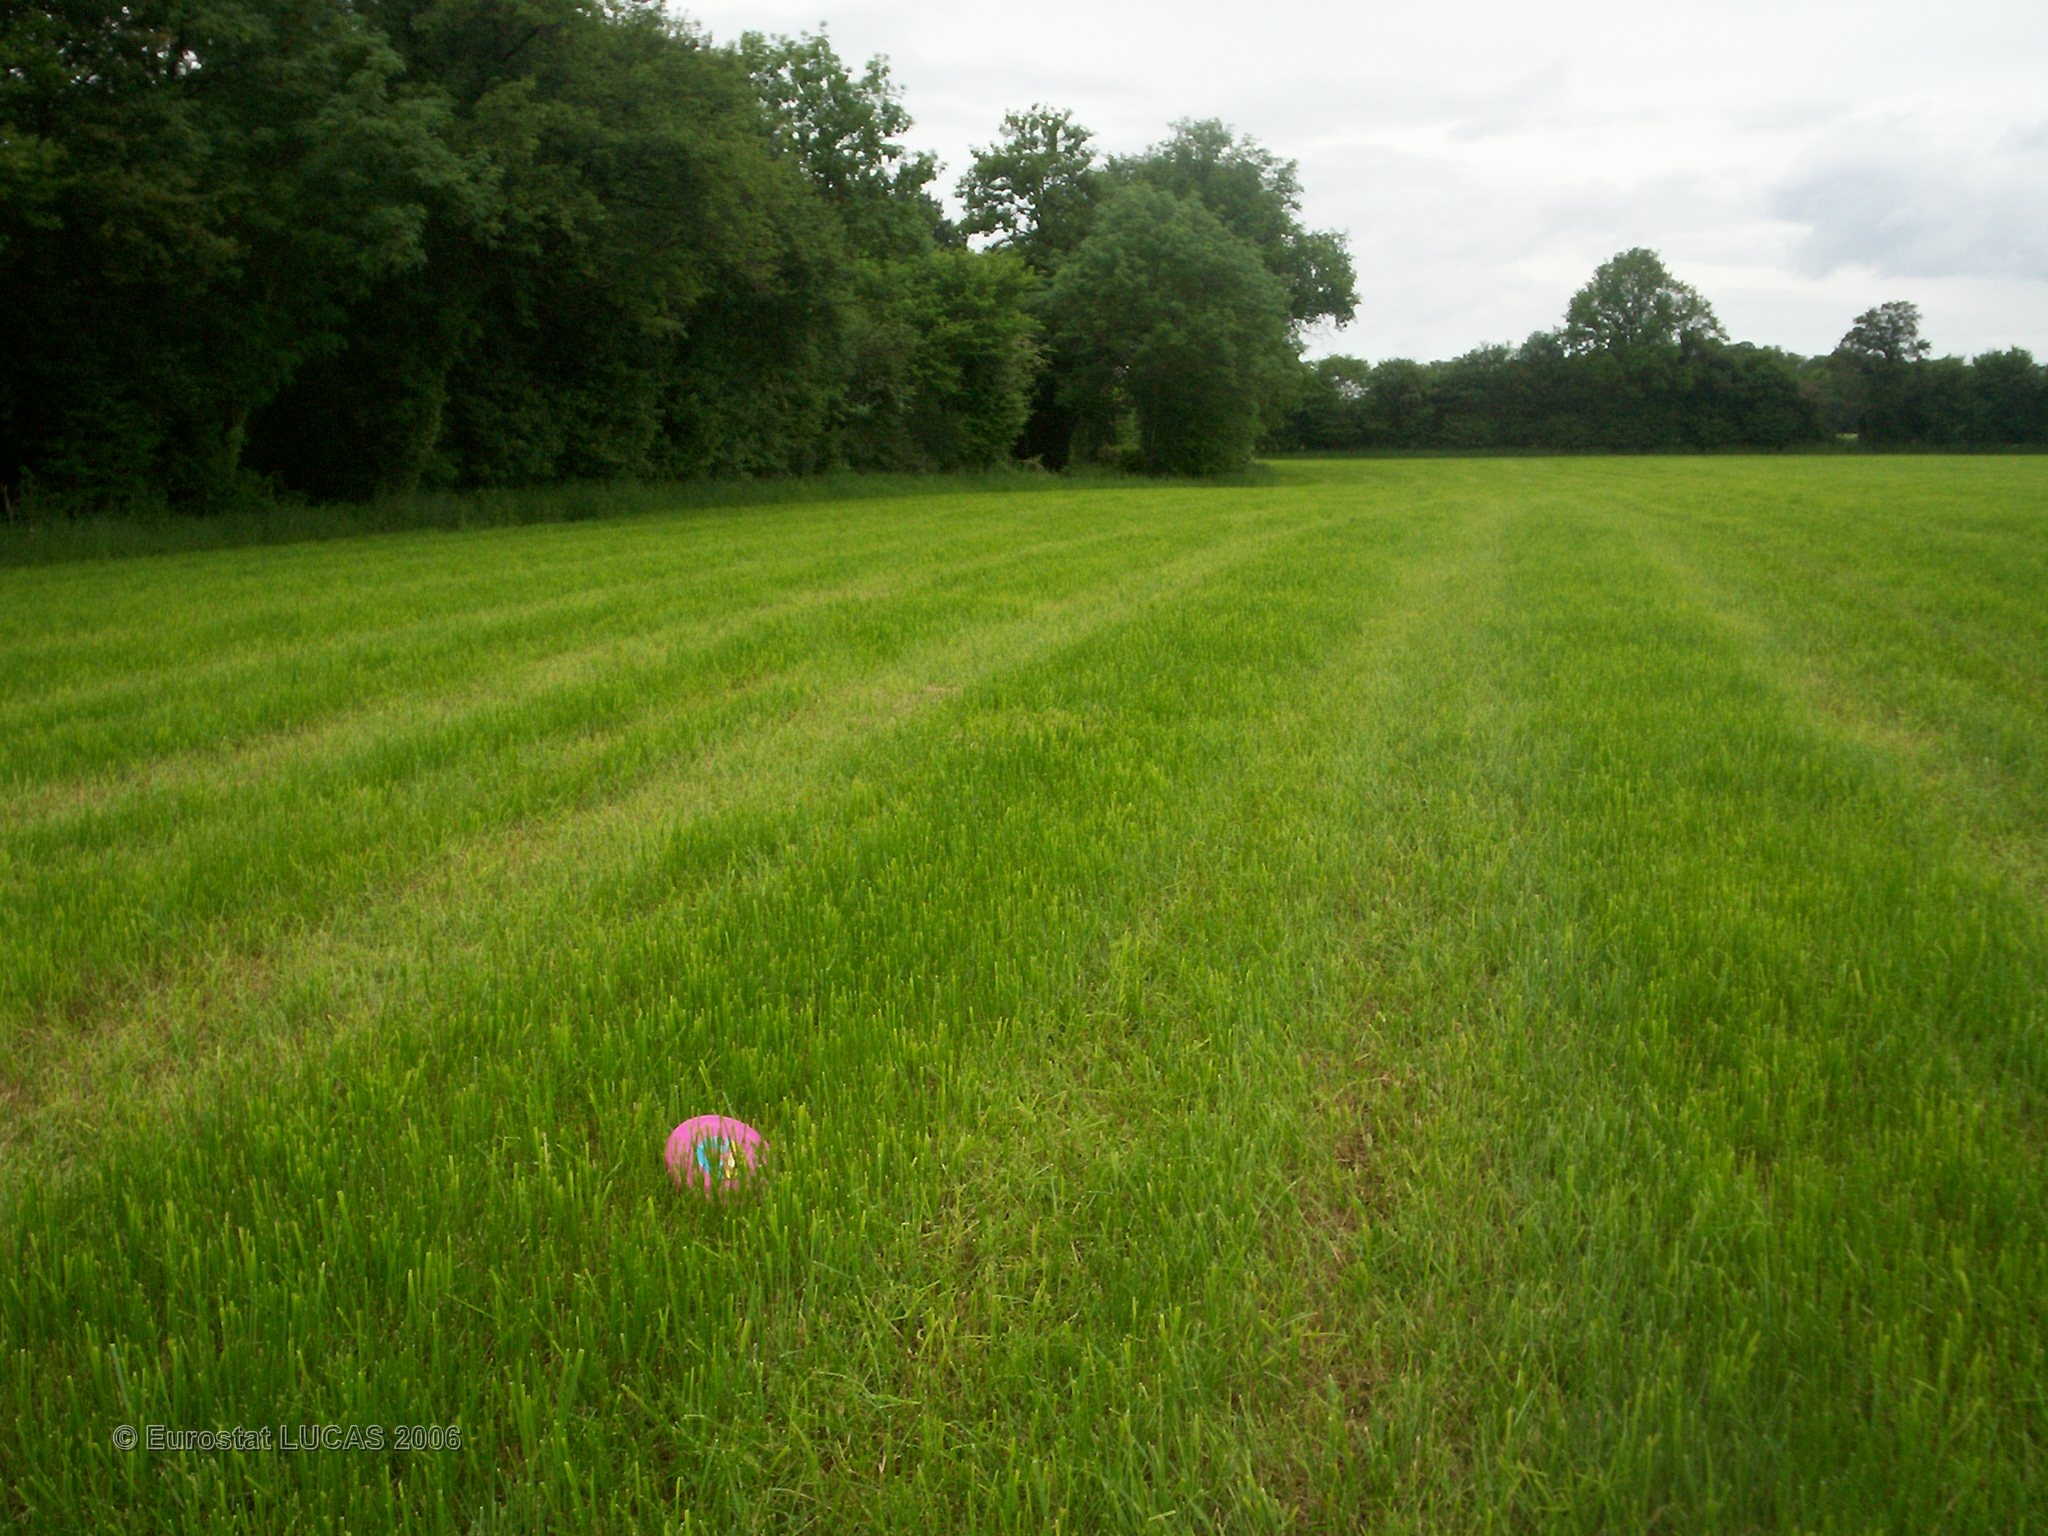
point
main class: Grassland
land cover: Grassland without tree/shrub cover
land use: Agriculture (excluding fallow land and kitchen gardens)
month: May
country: FR
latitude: 47.7961
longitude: 2.9041
